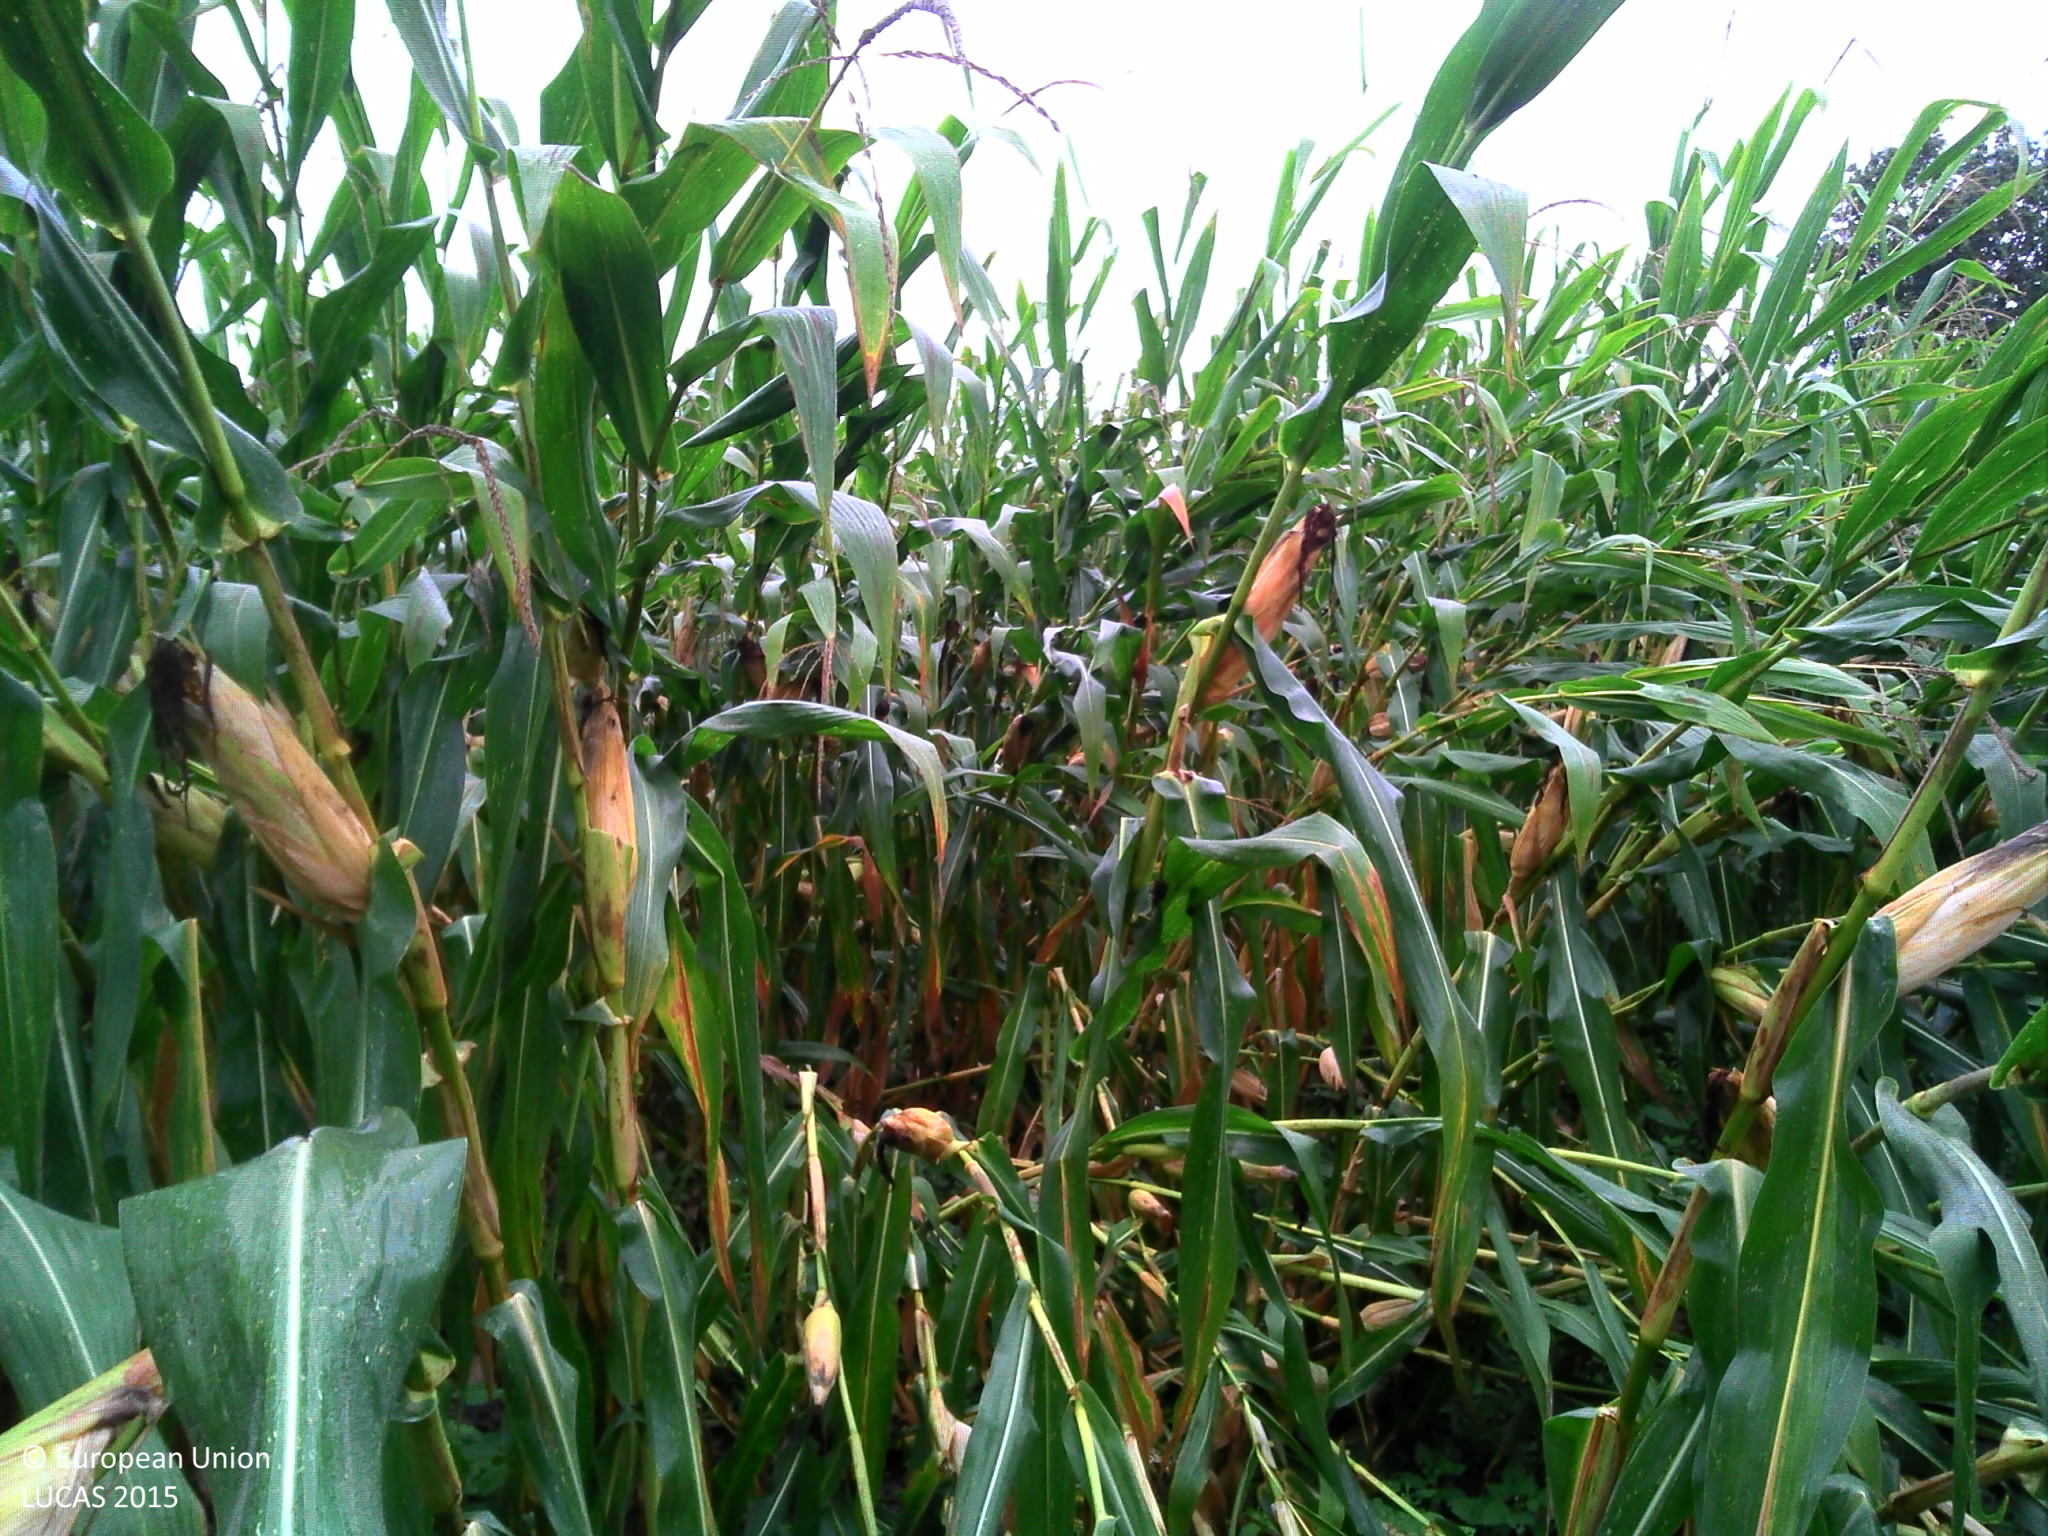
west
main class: Cropland
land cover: Maize
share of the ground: > 75 %
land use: Agriculture (excluding fallow land and kitchen gardens)
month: September
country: FR
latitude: 43.4859
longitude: -0.5317
